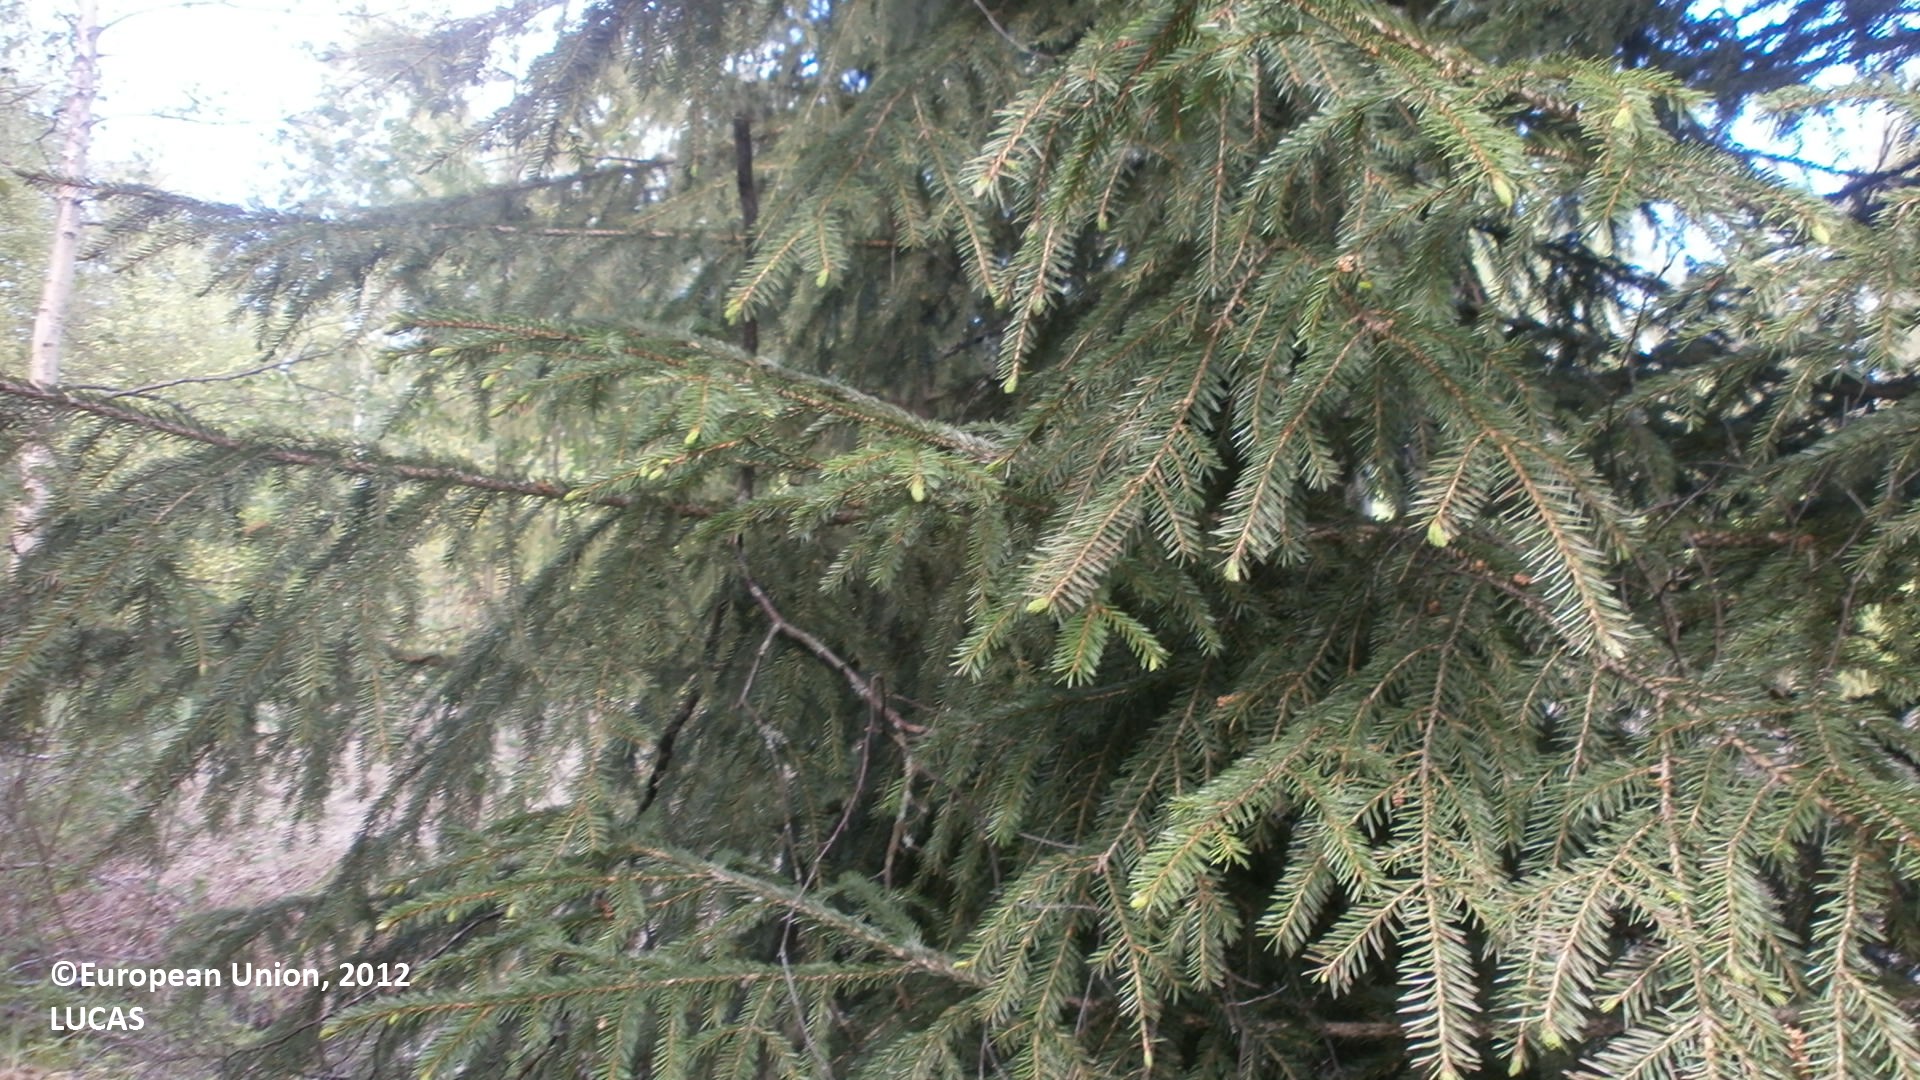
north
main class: Woodland
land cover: Spruce dominated coniferous woodland
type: mire and swamp forests
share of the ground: 50 - 75 %
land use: Forestry
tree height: > 5 m
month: June
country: FI
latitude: 64.5462
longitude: 25.2018
